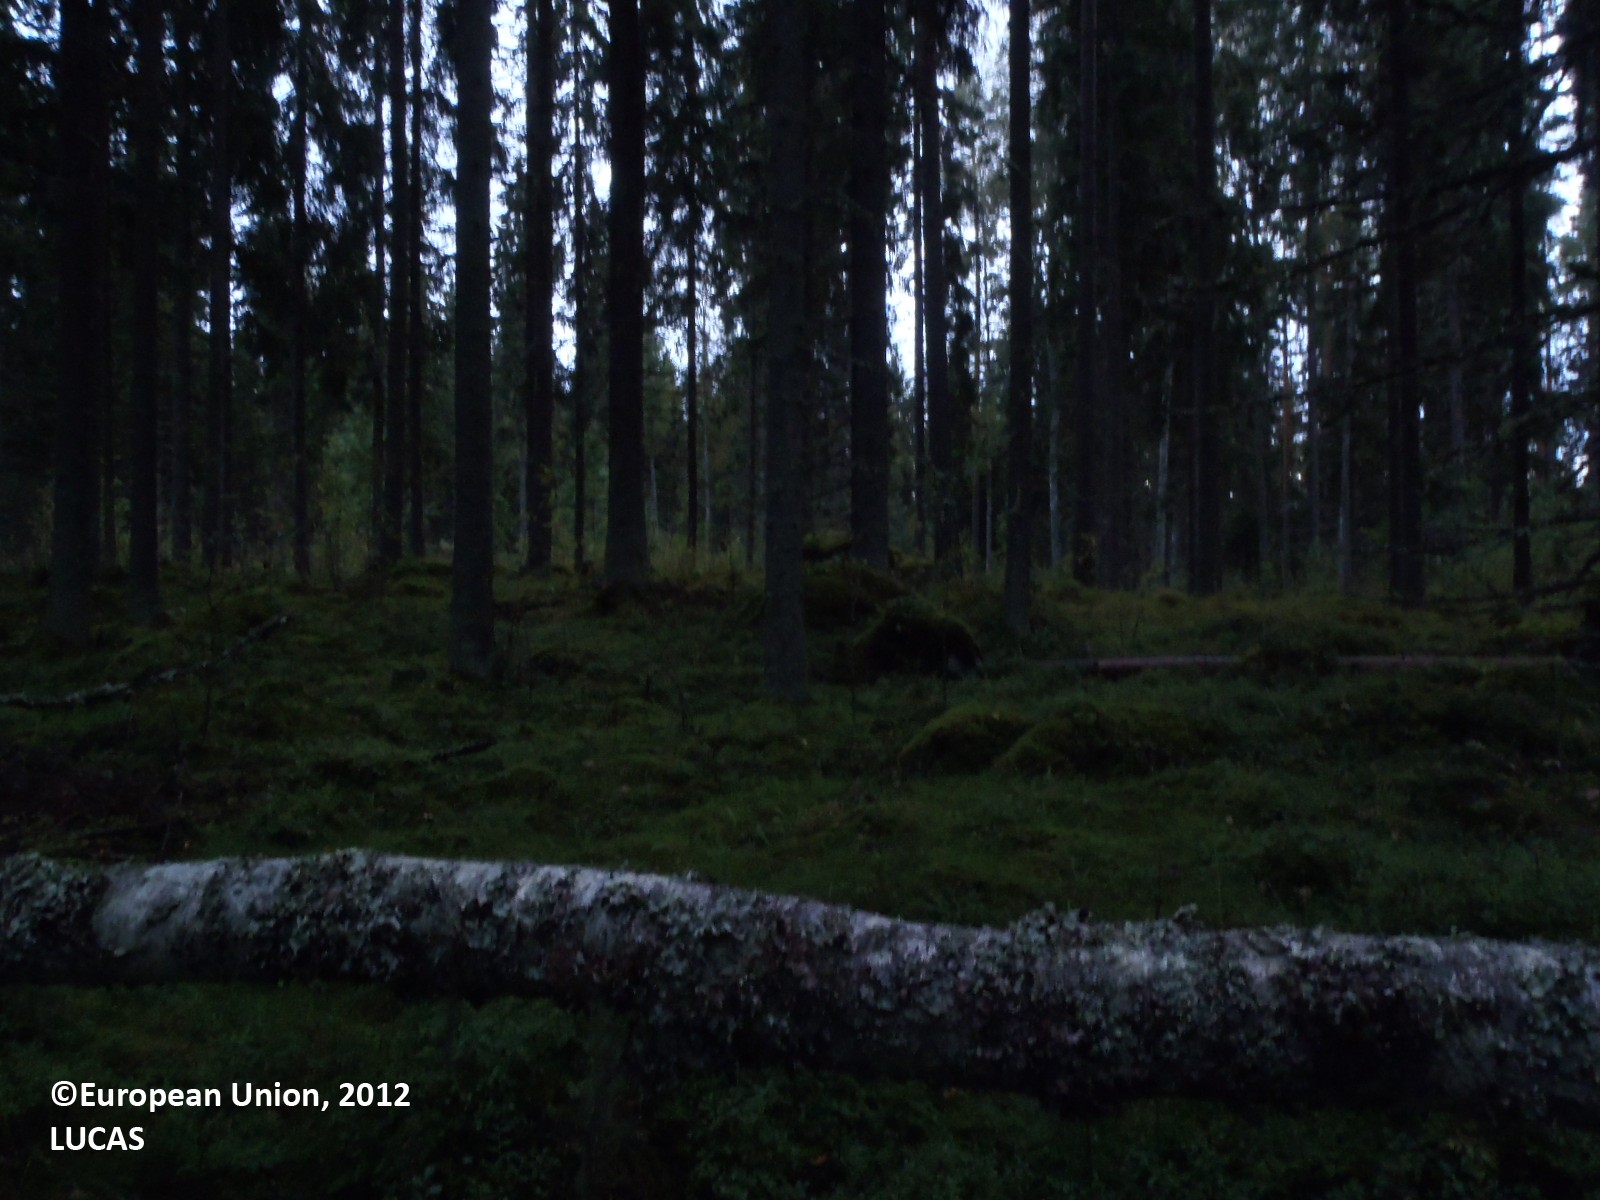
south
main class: Woodland
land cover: Spruce dominated coniferous woodland
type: boreal forest
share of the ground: > 75 %
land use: Forestry
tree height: > 5 m
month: September
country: FI
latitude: 61.7110
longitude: 22.6424
